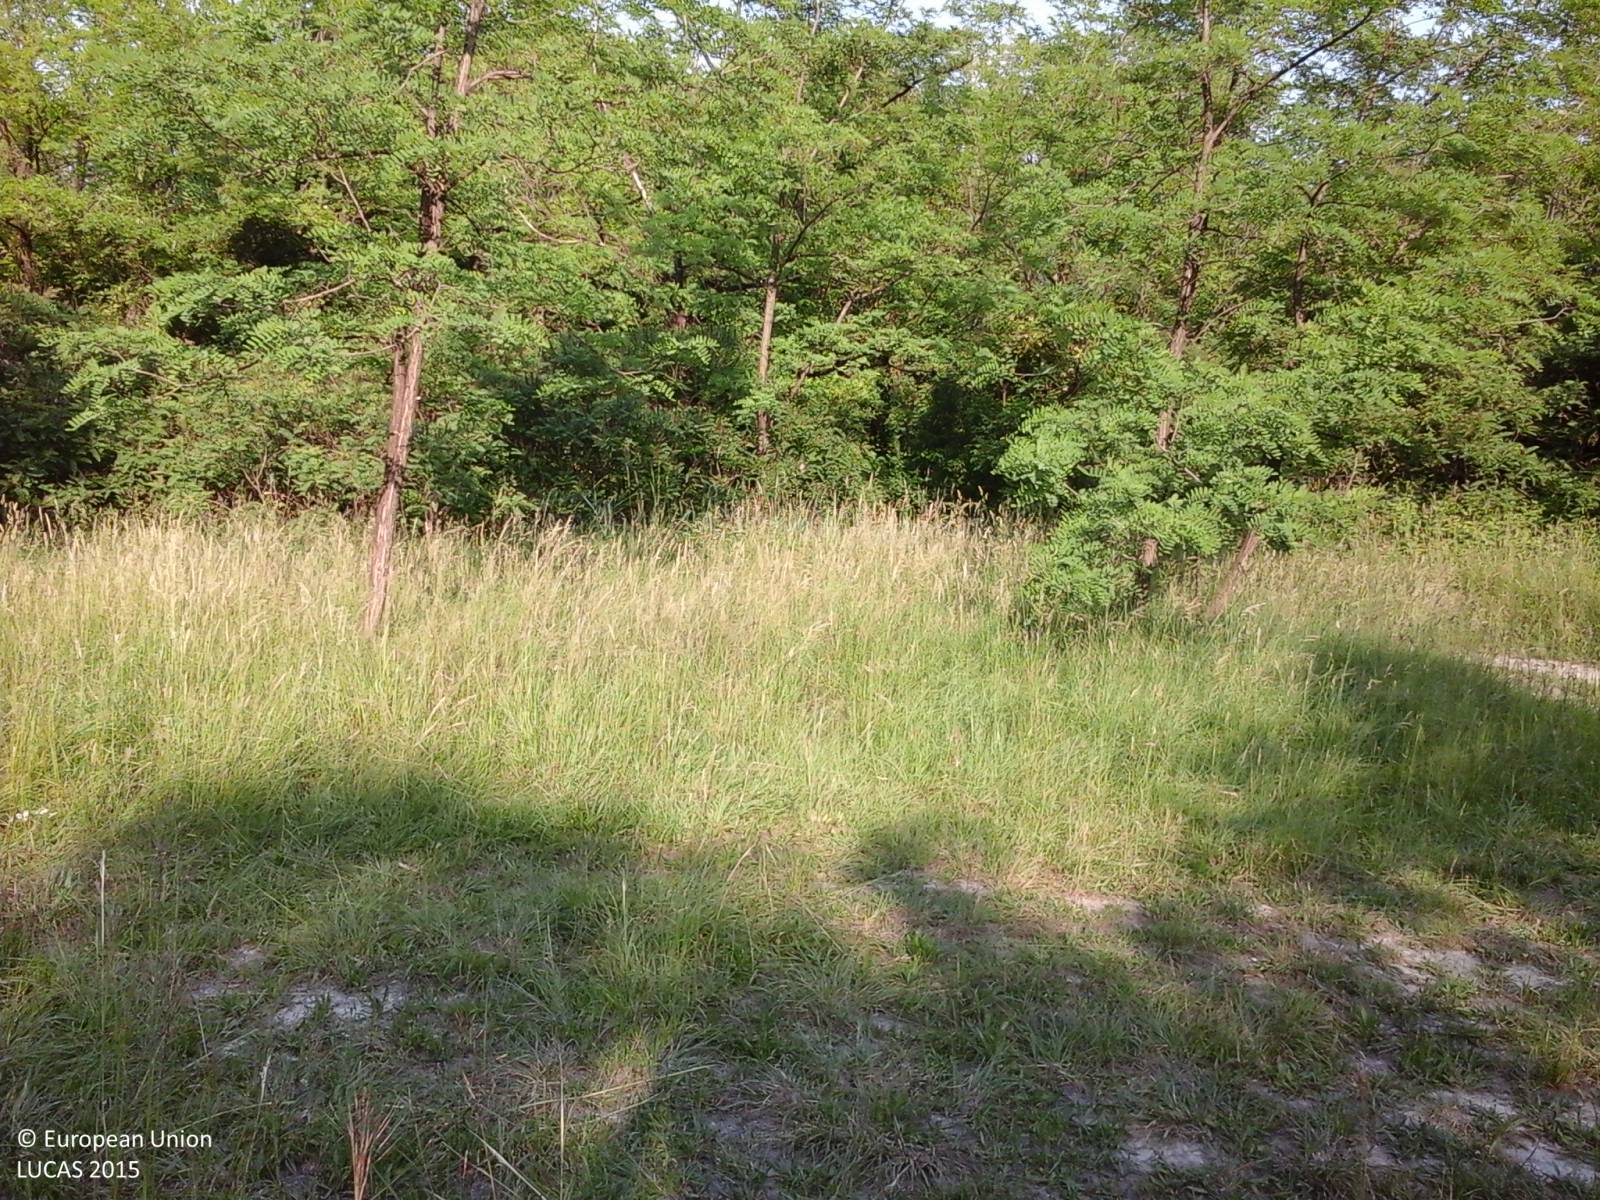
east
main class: Grassland
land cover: Grassland with sparse tree/shrub cover
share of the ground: > 75 %
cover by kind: herbaceous plants 95 %, broadleaved forest trees 5 %
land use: Semi-natural and natural areas not in use
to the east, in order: Grassland with sparse tree/shrub cover; Tracks; Broadleaved woodland; Tracks; Broadleaved woodland; Spontaneously vegetated surfaces; Broadleaved woodland; Railways; Electric lines; Broadleaved woodland; Grassland with sparse tree/shrub cover; Electric lines; Grassland with sparse tree/shrub cover; Spontaneously vegetated surfaces
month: May
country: IT
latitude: 45.8094
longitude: 13.4318
